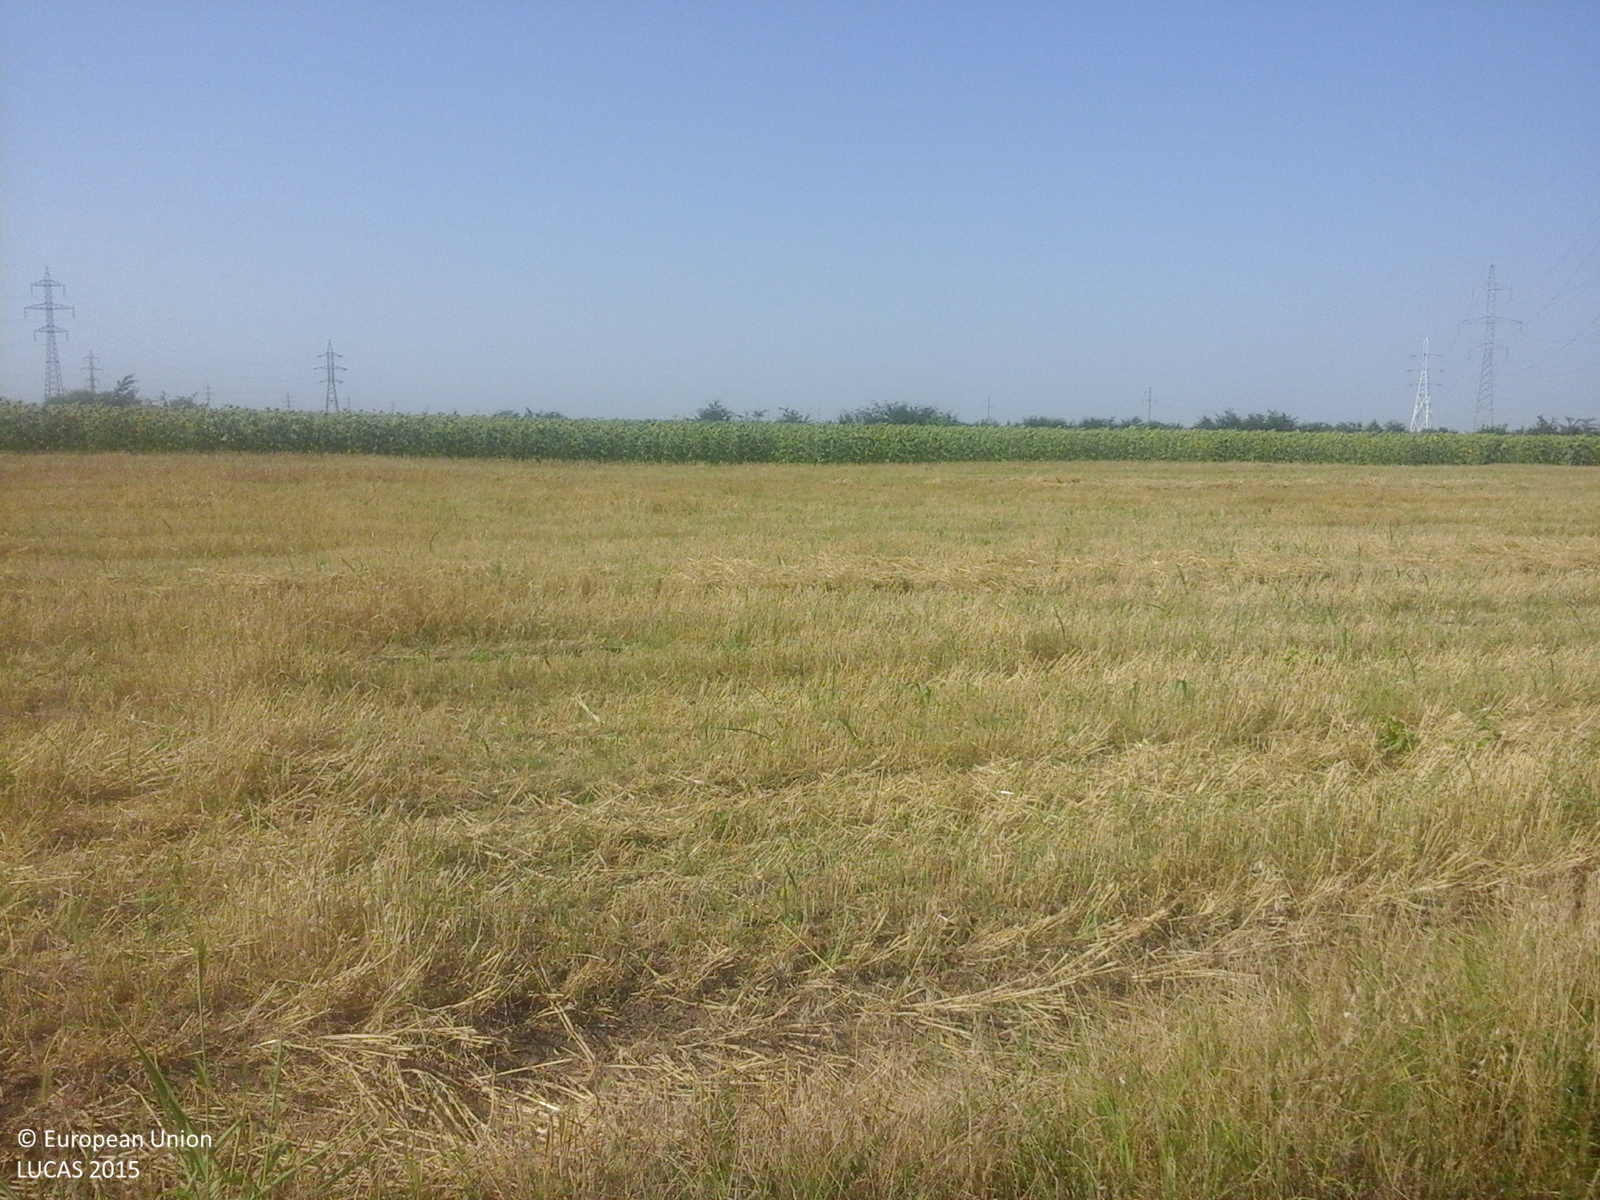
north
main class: Cropland
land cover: Sunflower
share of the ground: > 75 %
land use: Agriculture (excluding fallow land and kitchen gardens)
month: July
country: RO
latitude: 44.1986
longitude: 27.3656
